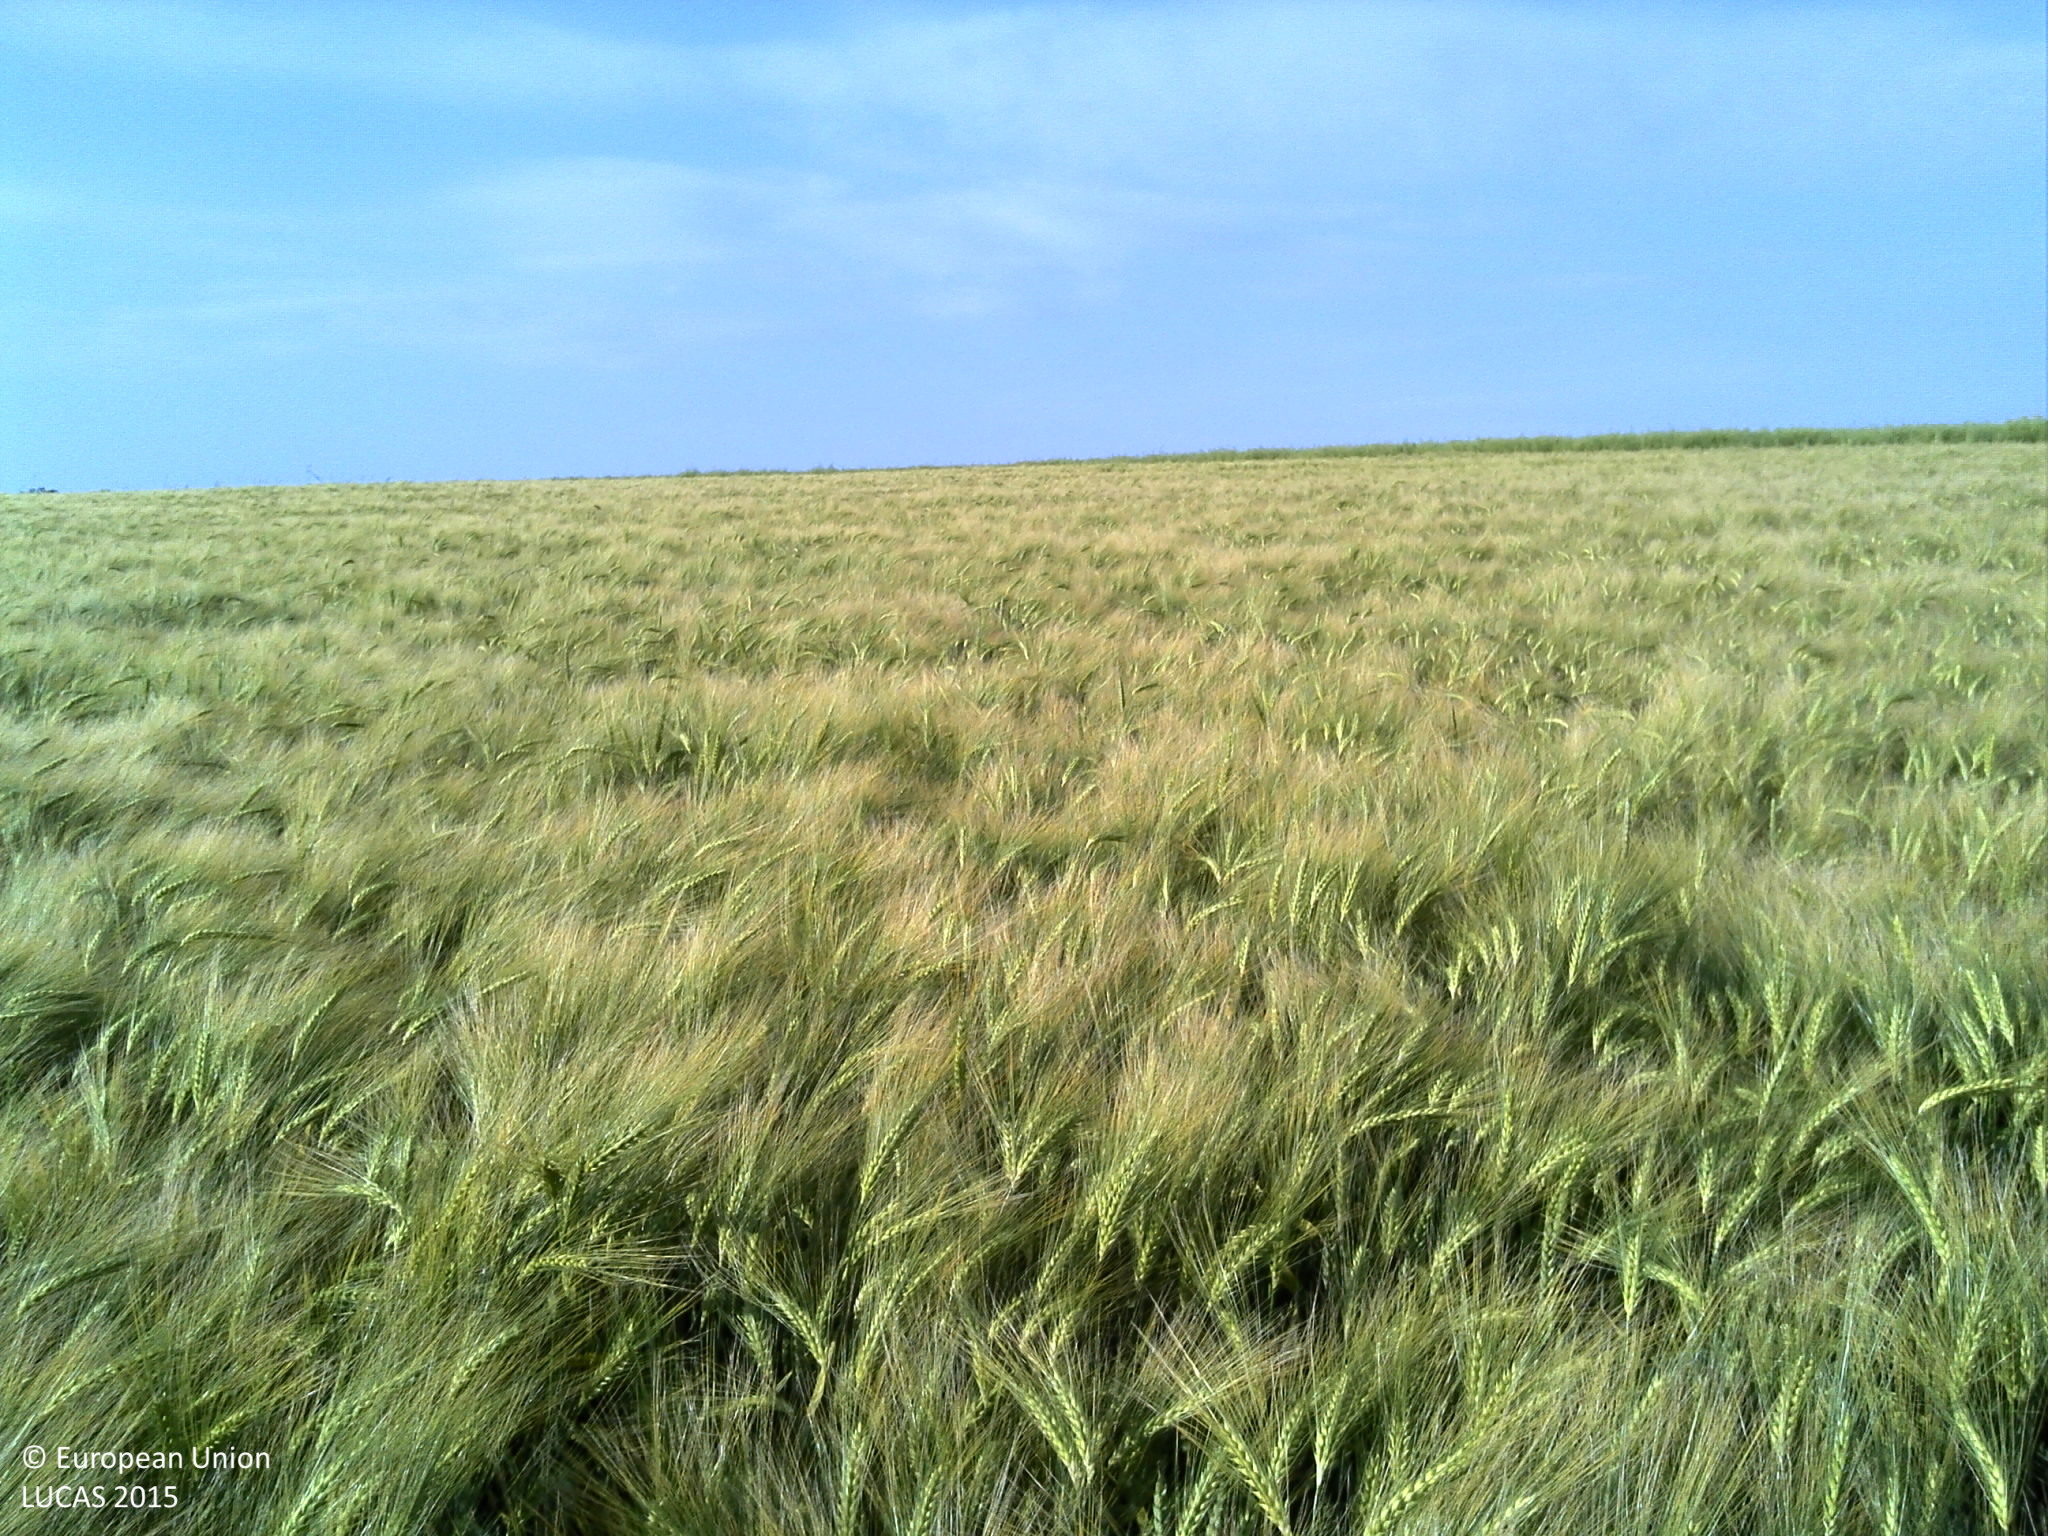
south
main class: Cropland
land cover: Barley
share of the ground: > 75 %
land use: Agriculture (excluding fallow land and kitchen gardens)
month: June
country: FR
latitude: 49.6903
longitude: 1.0927
